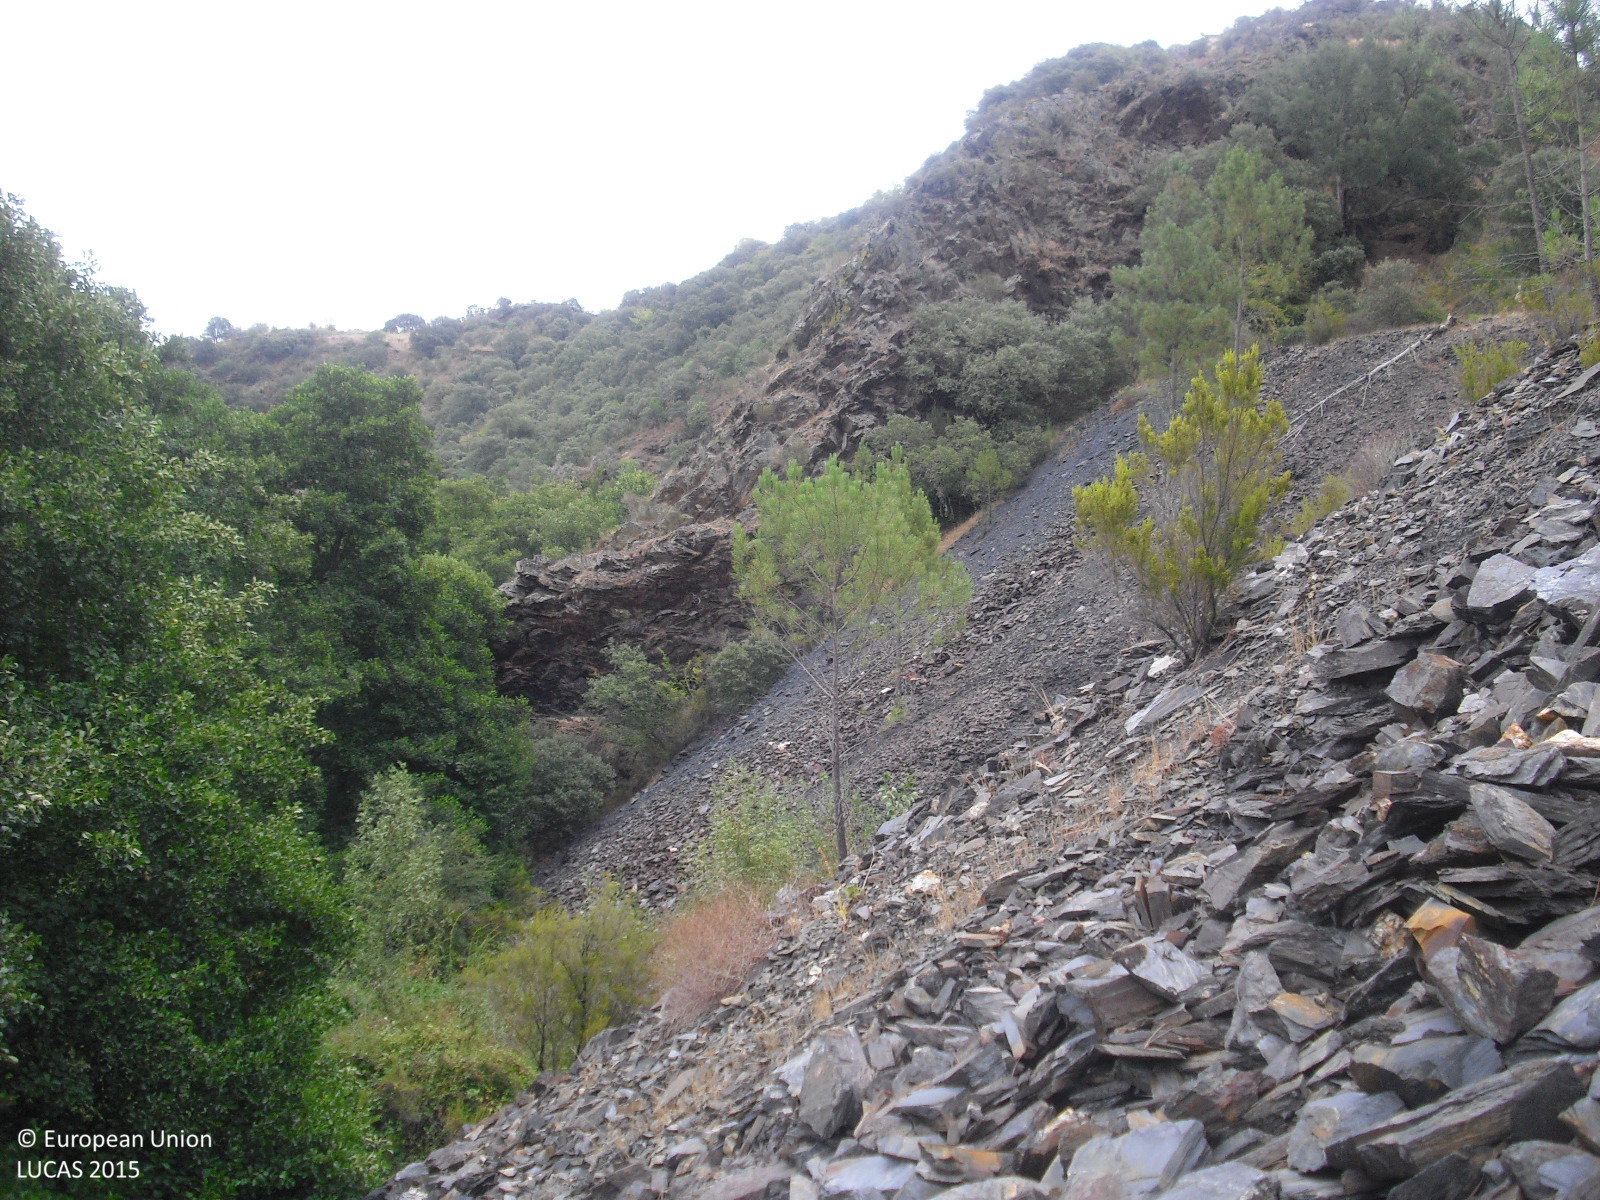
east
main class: Woodland
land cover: Broadleaved woodland
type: floodplain forest
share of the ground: 50 - 75 %
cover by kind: broadleaved forest trees 60 %, consolidated bare surface 30 %, shrubs 10 %
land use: Semi-natural and natural areas not in use
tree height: > 5 m
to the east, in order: Broadleaved woodland; Rocks and stones; Shrubland with sparse tree cover; Rock outcrops; Broadleaved woodland
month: July
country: ES
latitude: 42.3858
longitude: -7.1982
